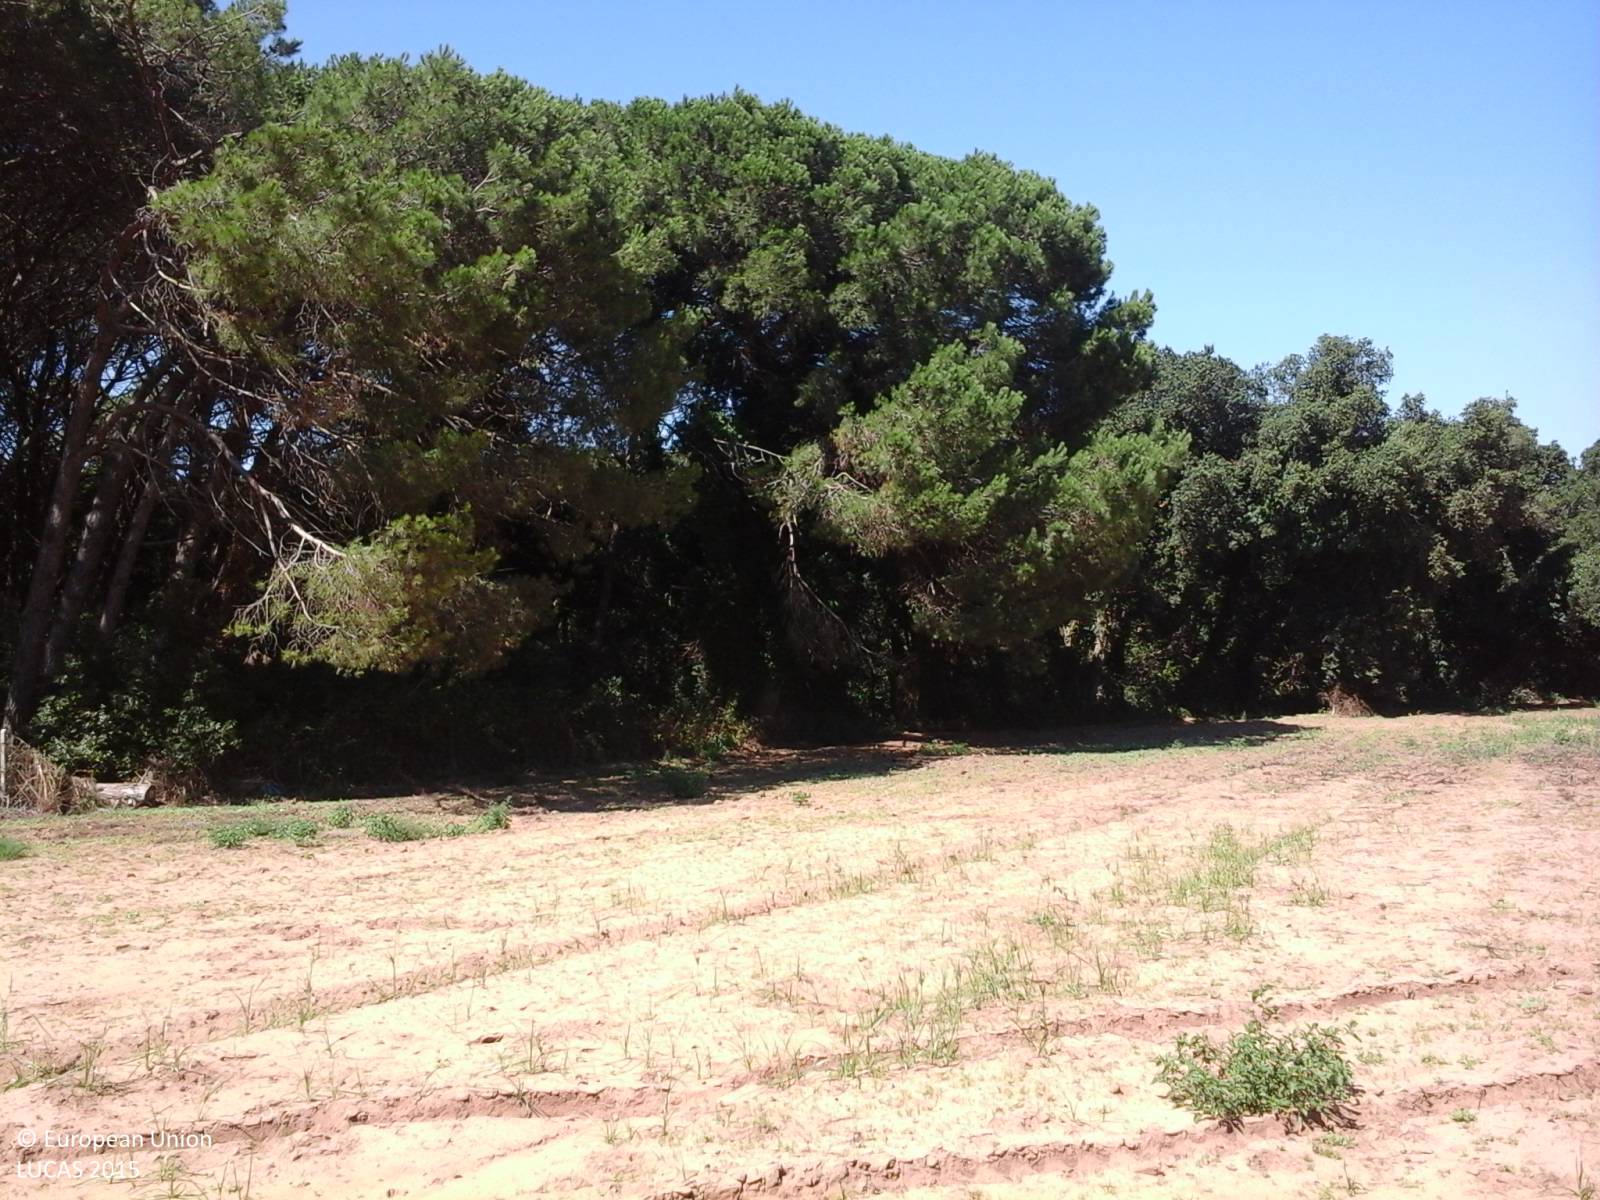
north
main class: Grassland
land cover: Spontaneously vegetated surfaces
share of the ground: > 75 %
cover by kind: herbaceous plants 100 %
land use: Agriculture (excluding fallow land and kitchen gardens)
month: August
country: IT
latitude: 41.2698
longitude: 13.0553
